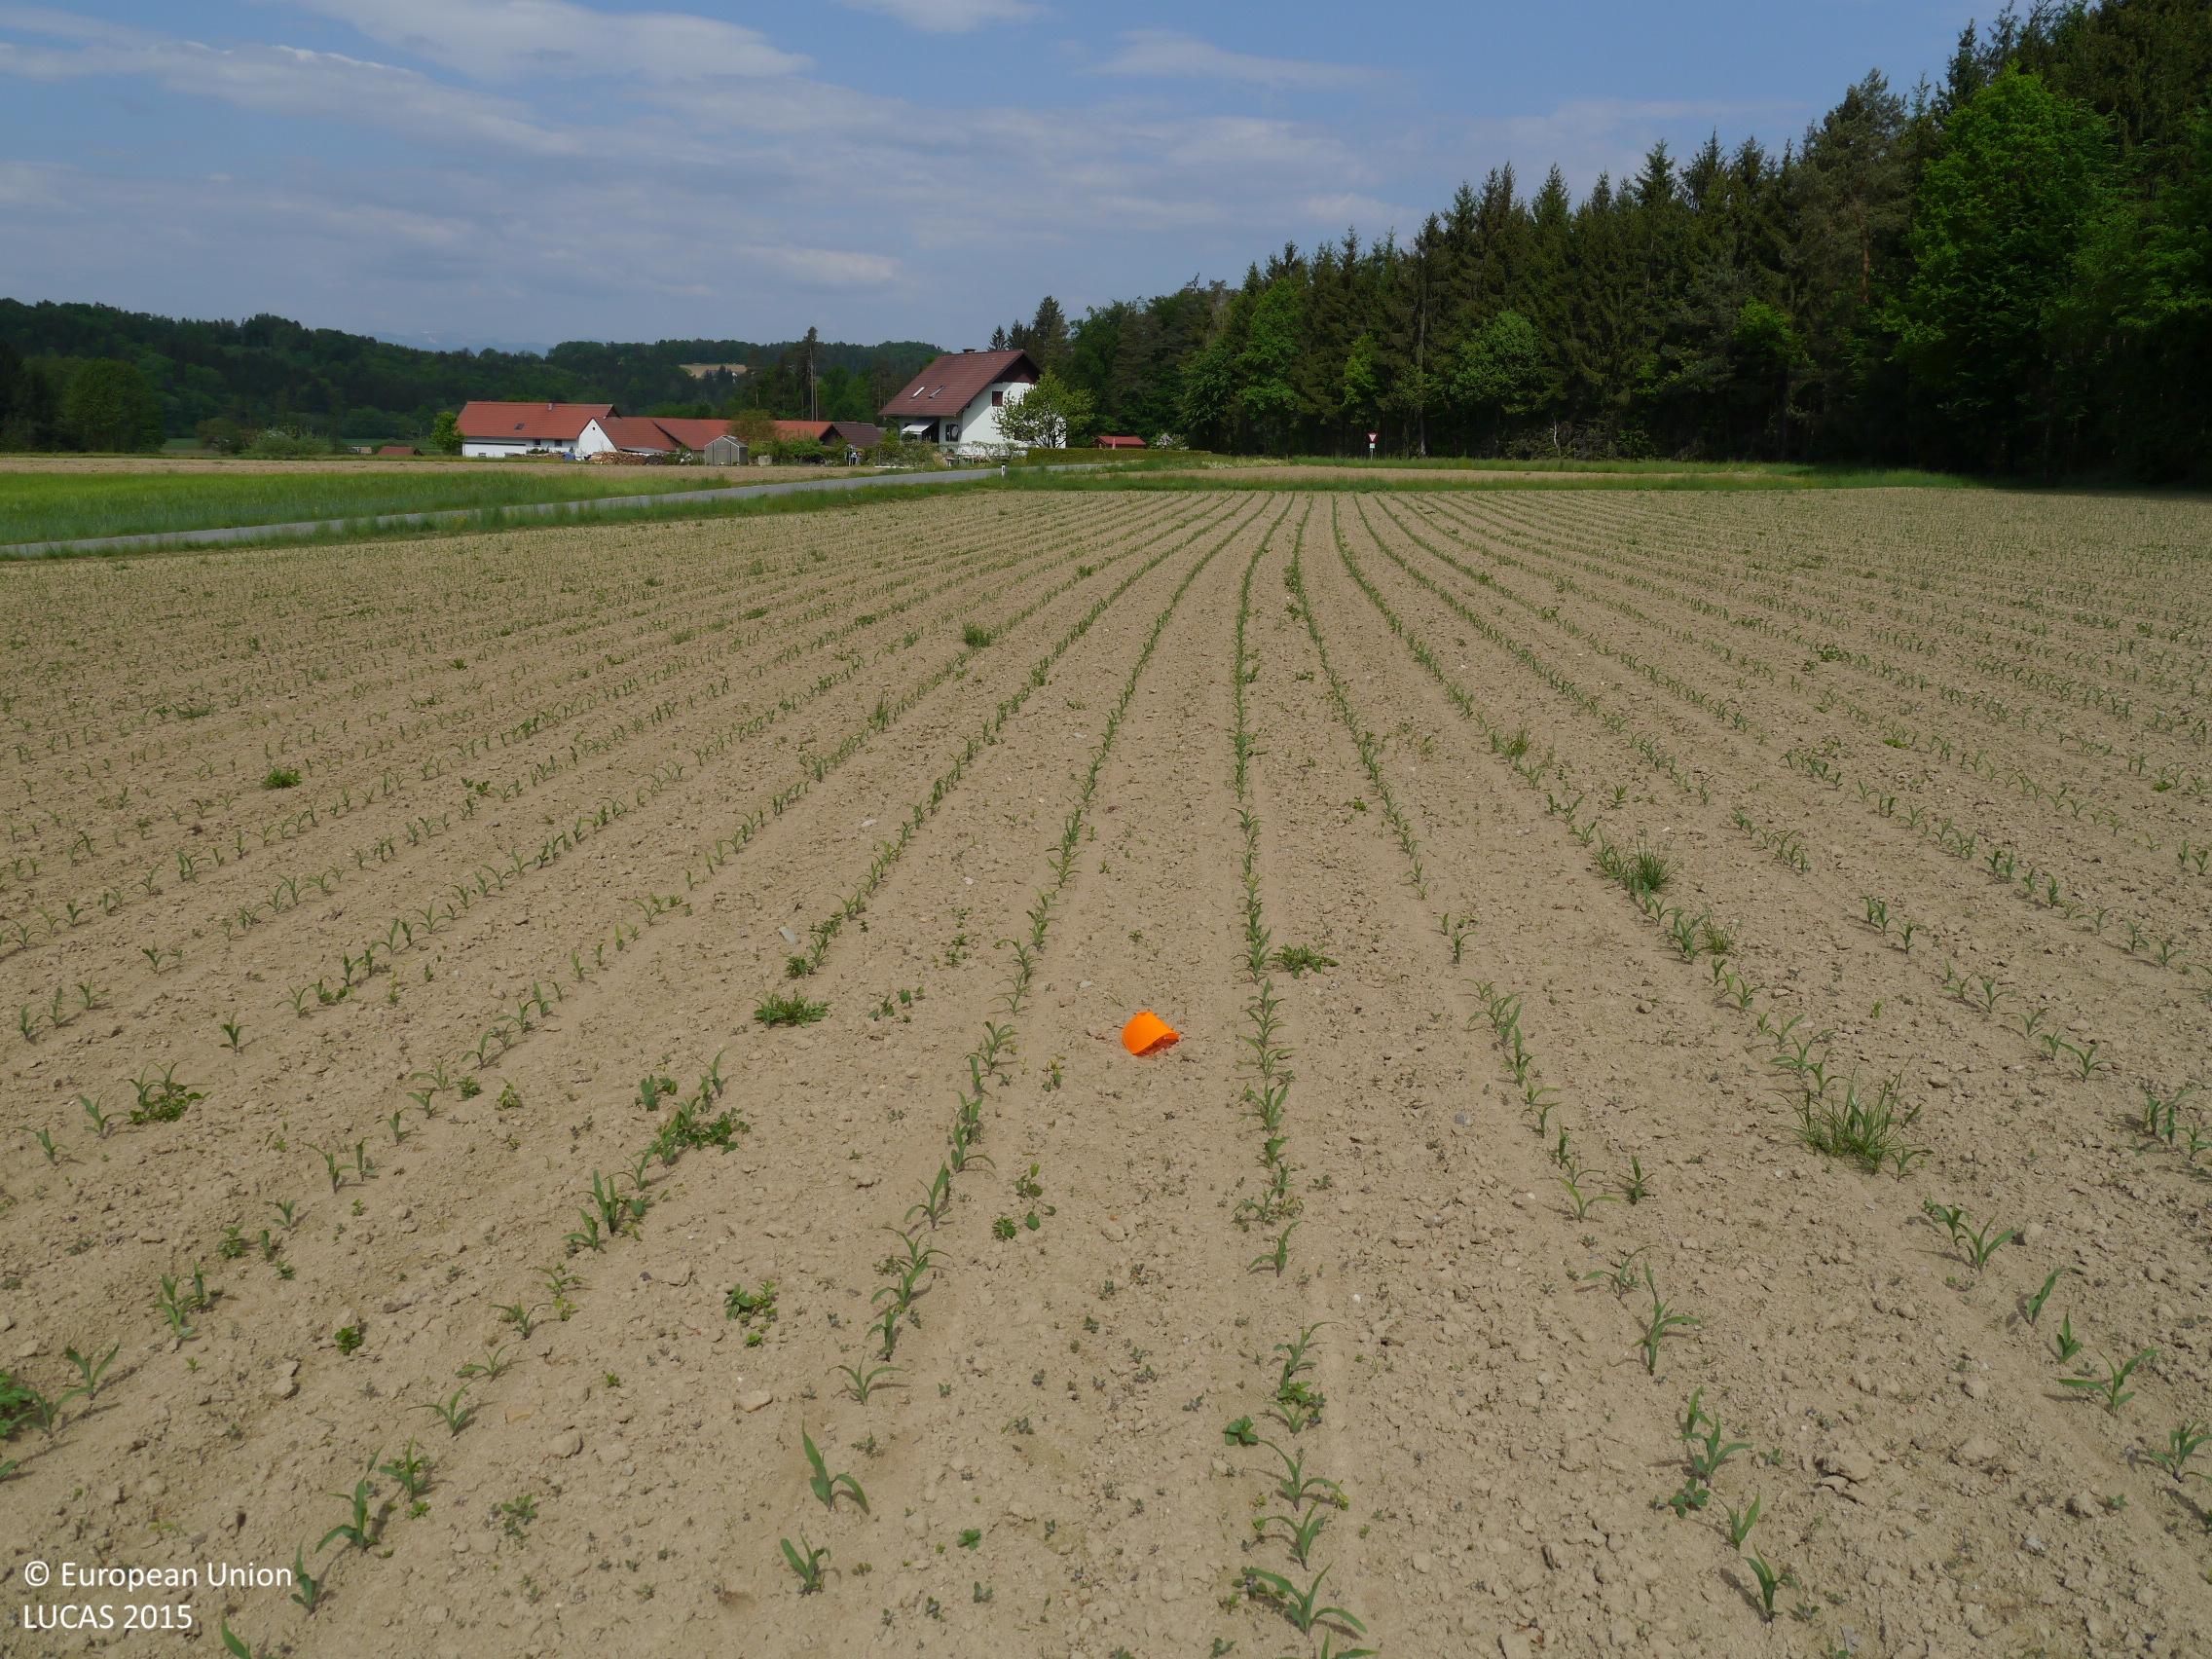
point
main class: Cropland
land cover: Maize
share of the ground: < 10 %
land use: Agriculture (excluding fallow land and kitchen gardens)
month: May
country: AT
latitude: 47.0125
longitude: 15.3270
